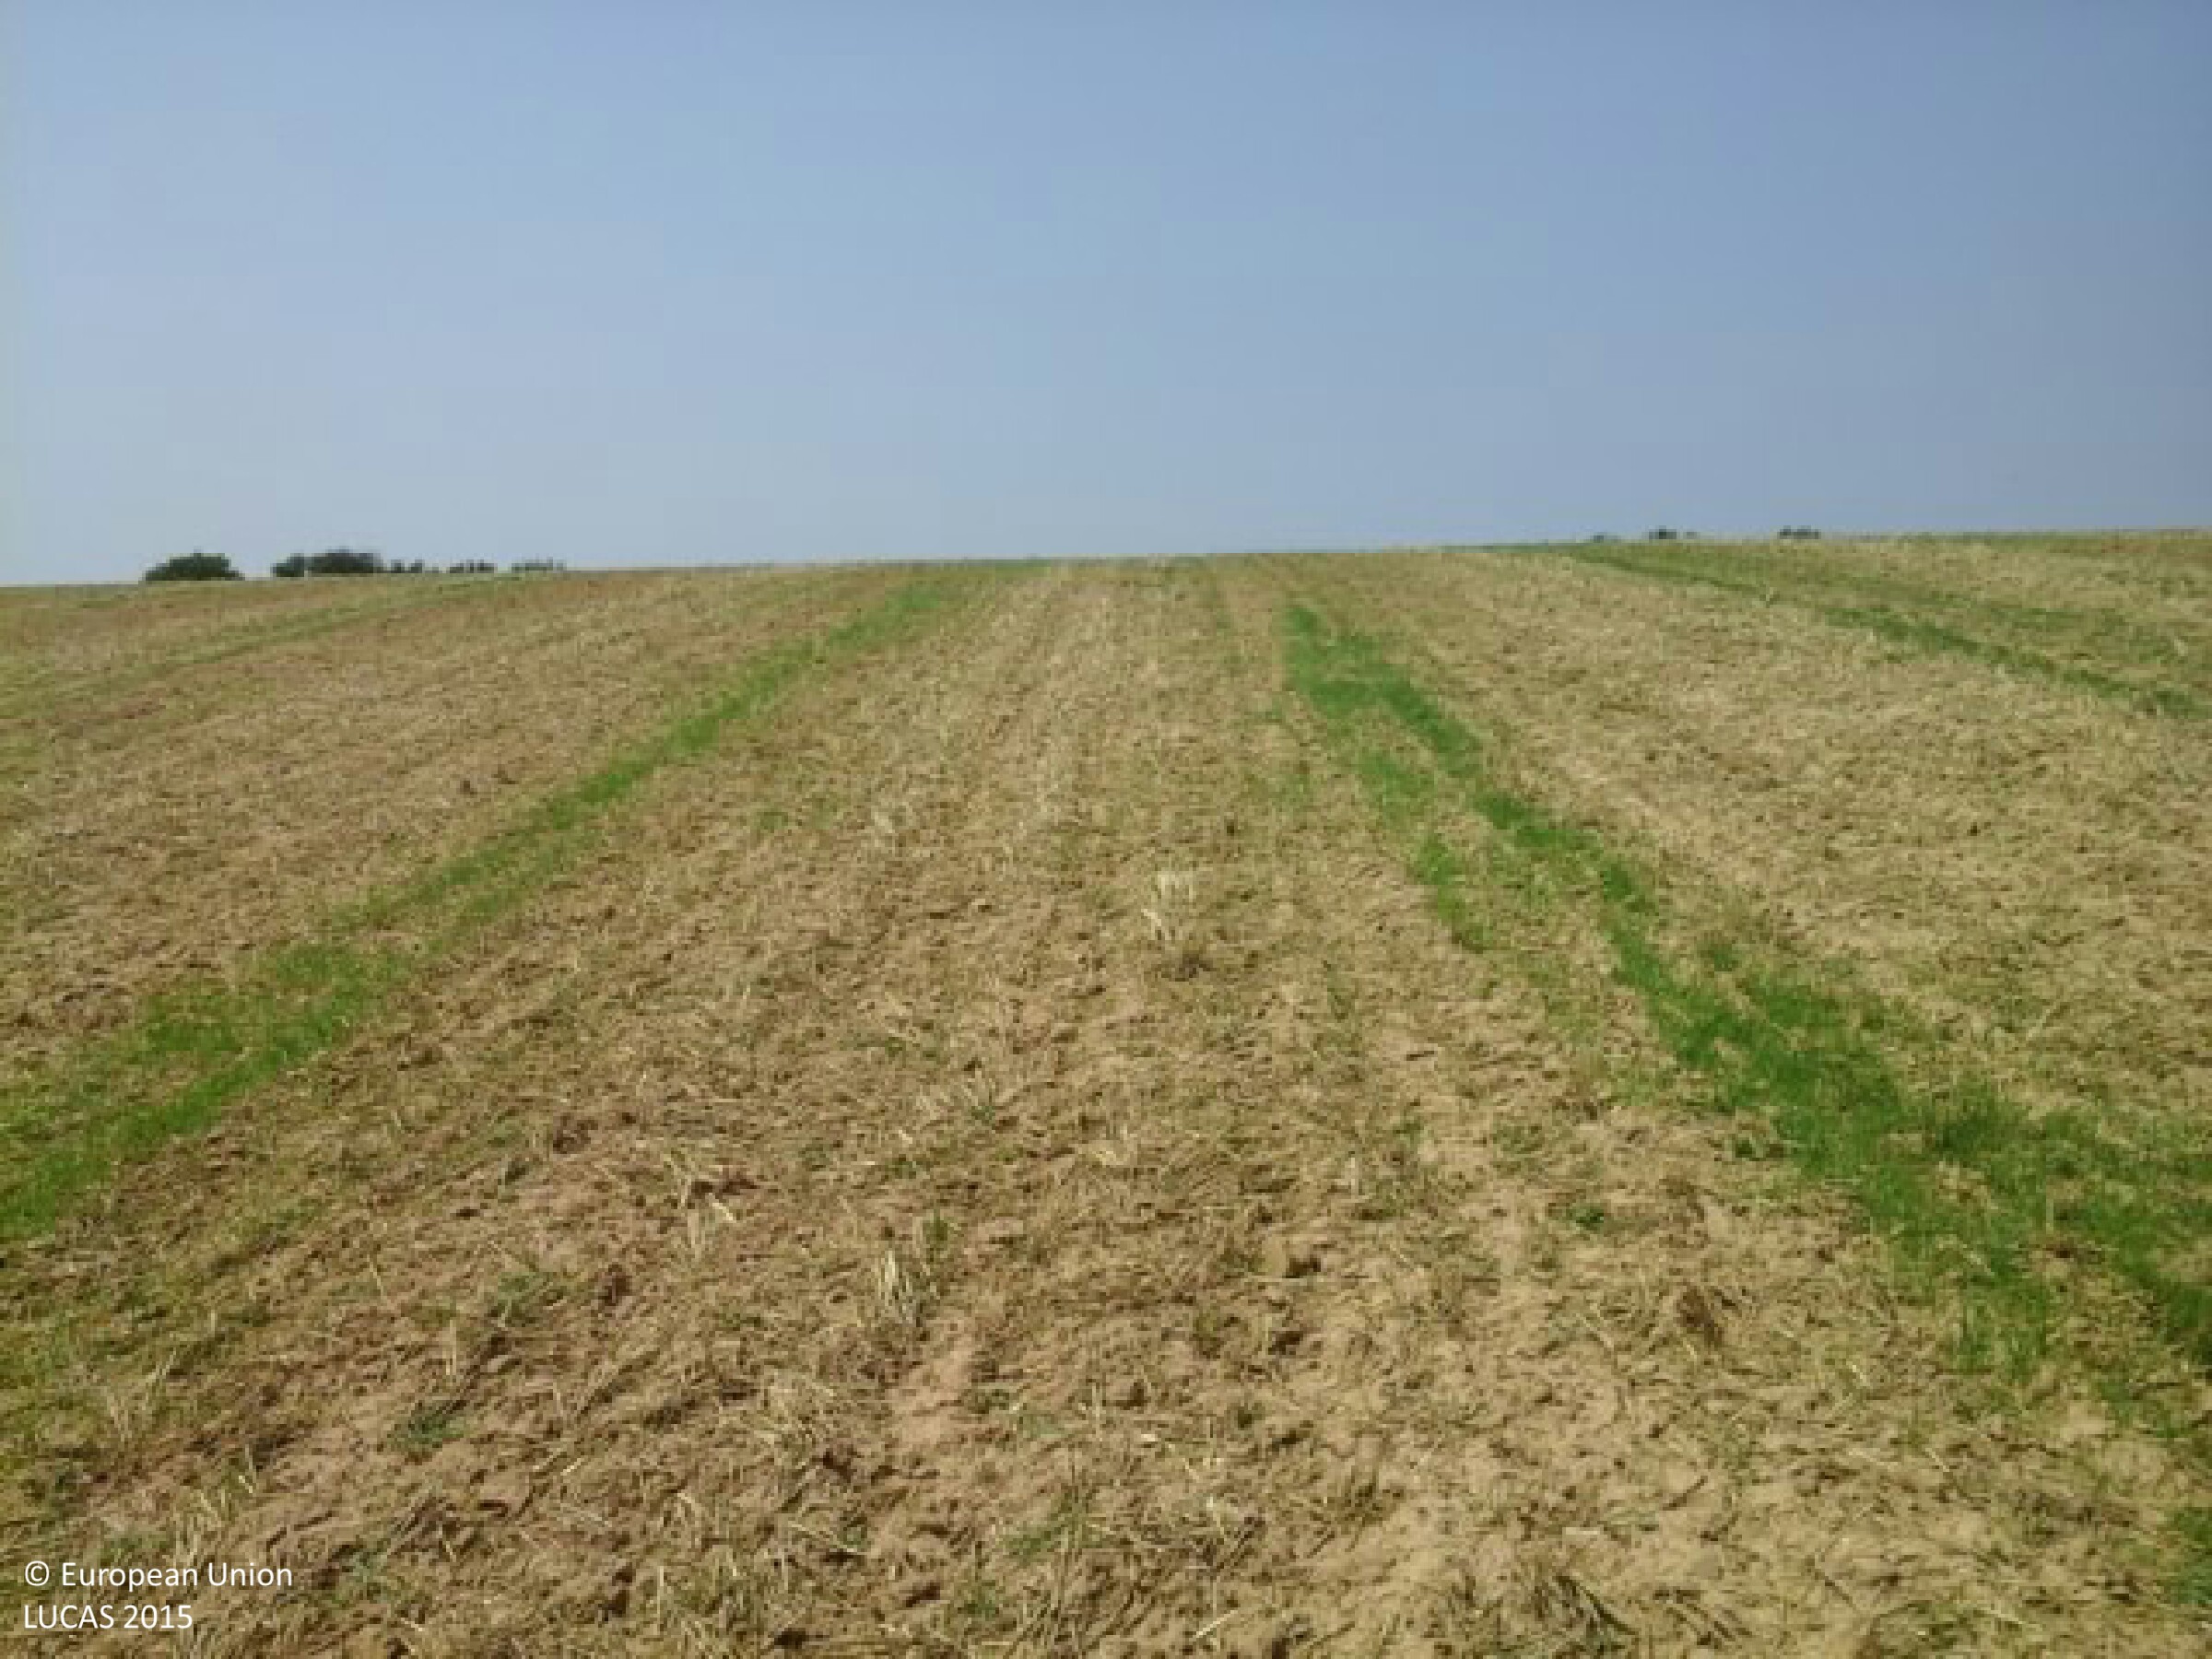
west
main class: Cropland
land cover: Common wheat
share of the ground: > 75 %
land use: Agriculture (excluding fallow land and kitchen gardens)
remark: Harvested field
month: August
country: HU
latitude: 46.5289
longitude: 17.3967
